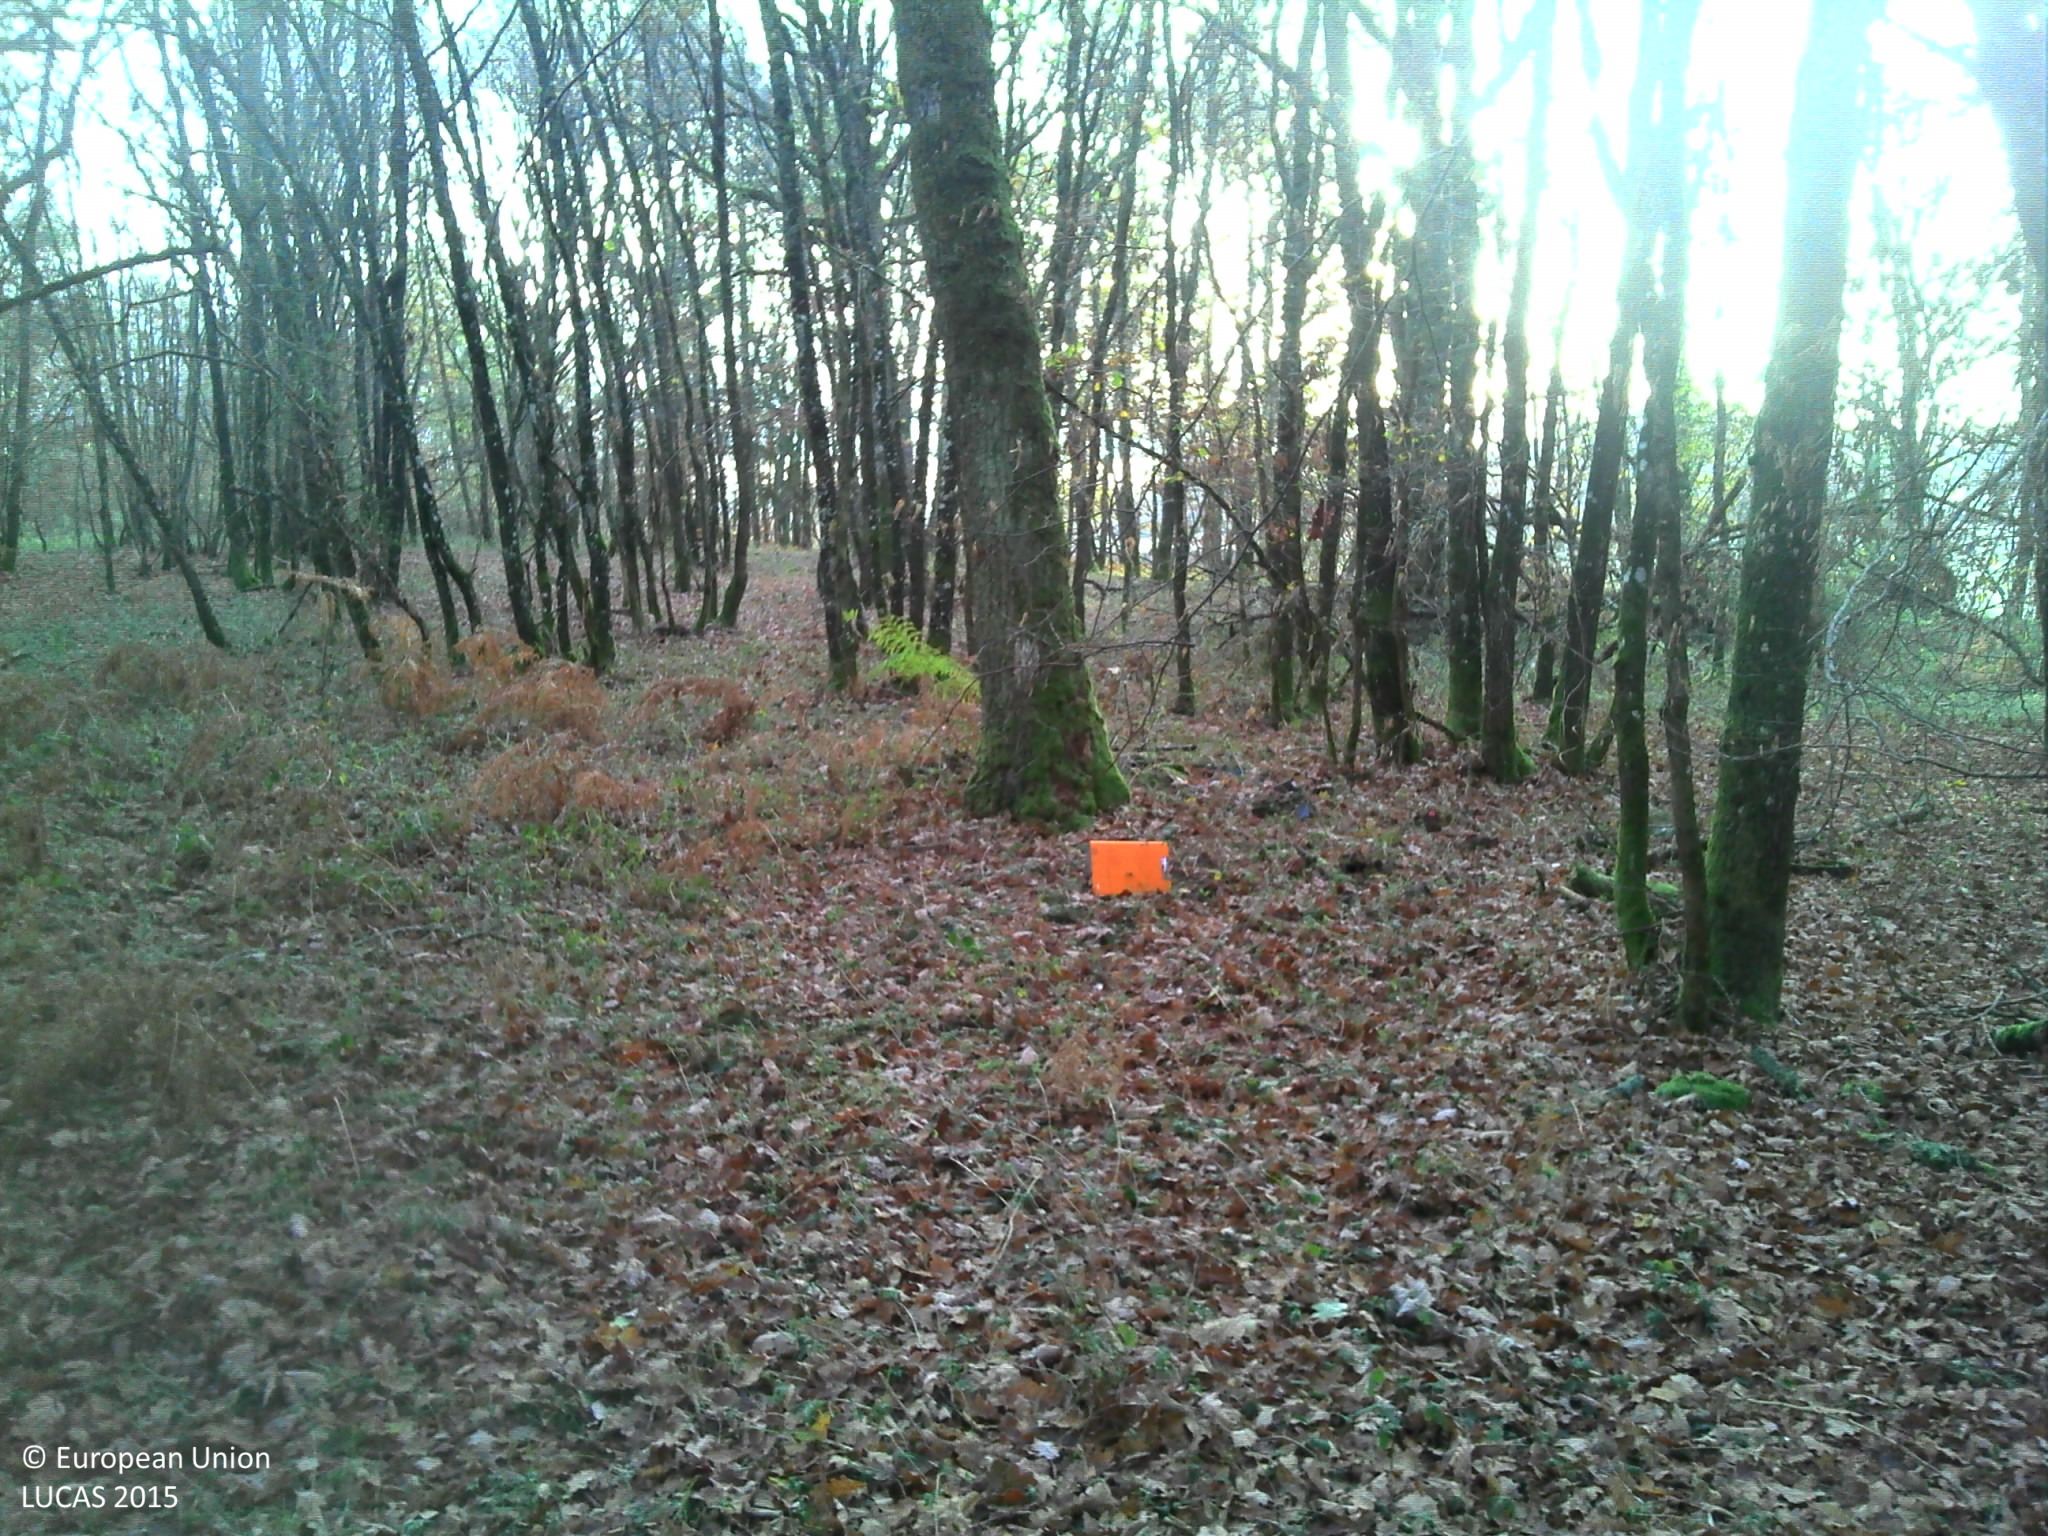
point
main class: Woodland
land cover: Broadleaved woodland
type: acidophilous oak and oak-birch forest
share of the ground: 50 - 75 %
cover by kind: broadleaved forest trees 70 %, unconsolidated bare surface 15 %, shrubs 5 %, herbaceous plants 5 %, lichens and mosses 5 %
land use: Forestry
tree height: > 5 m
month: November
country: FR
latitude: 46.2189
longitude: 3.6869
